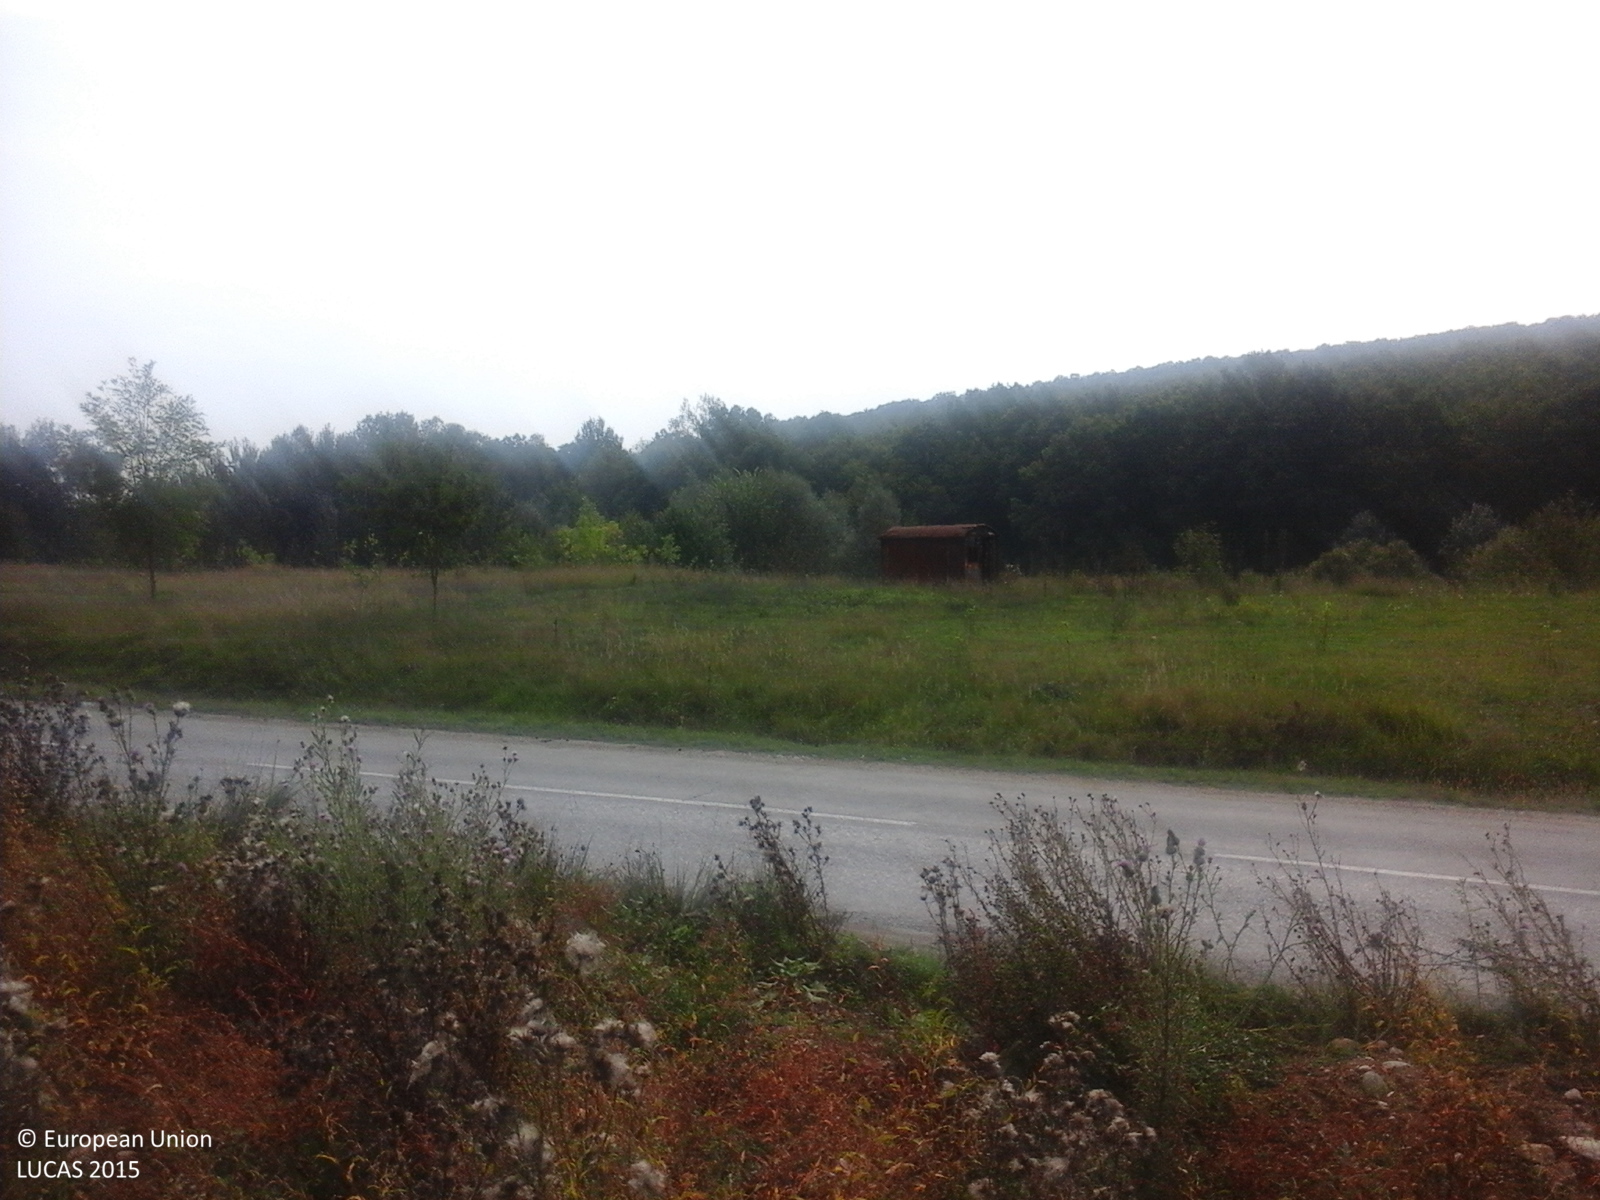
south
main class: Grassland
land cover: Spontaneously vegetated surfaces
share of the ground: > 75 %
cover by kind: herbaceous plants 100 %
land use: Fallow land
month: September
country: RO
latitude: 45.0520
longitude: 23.2203
